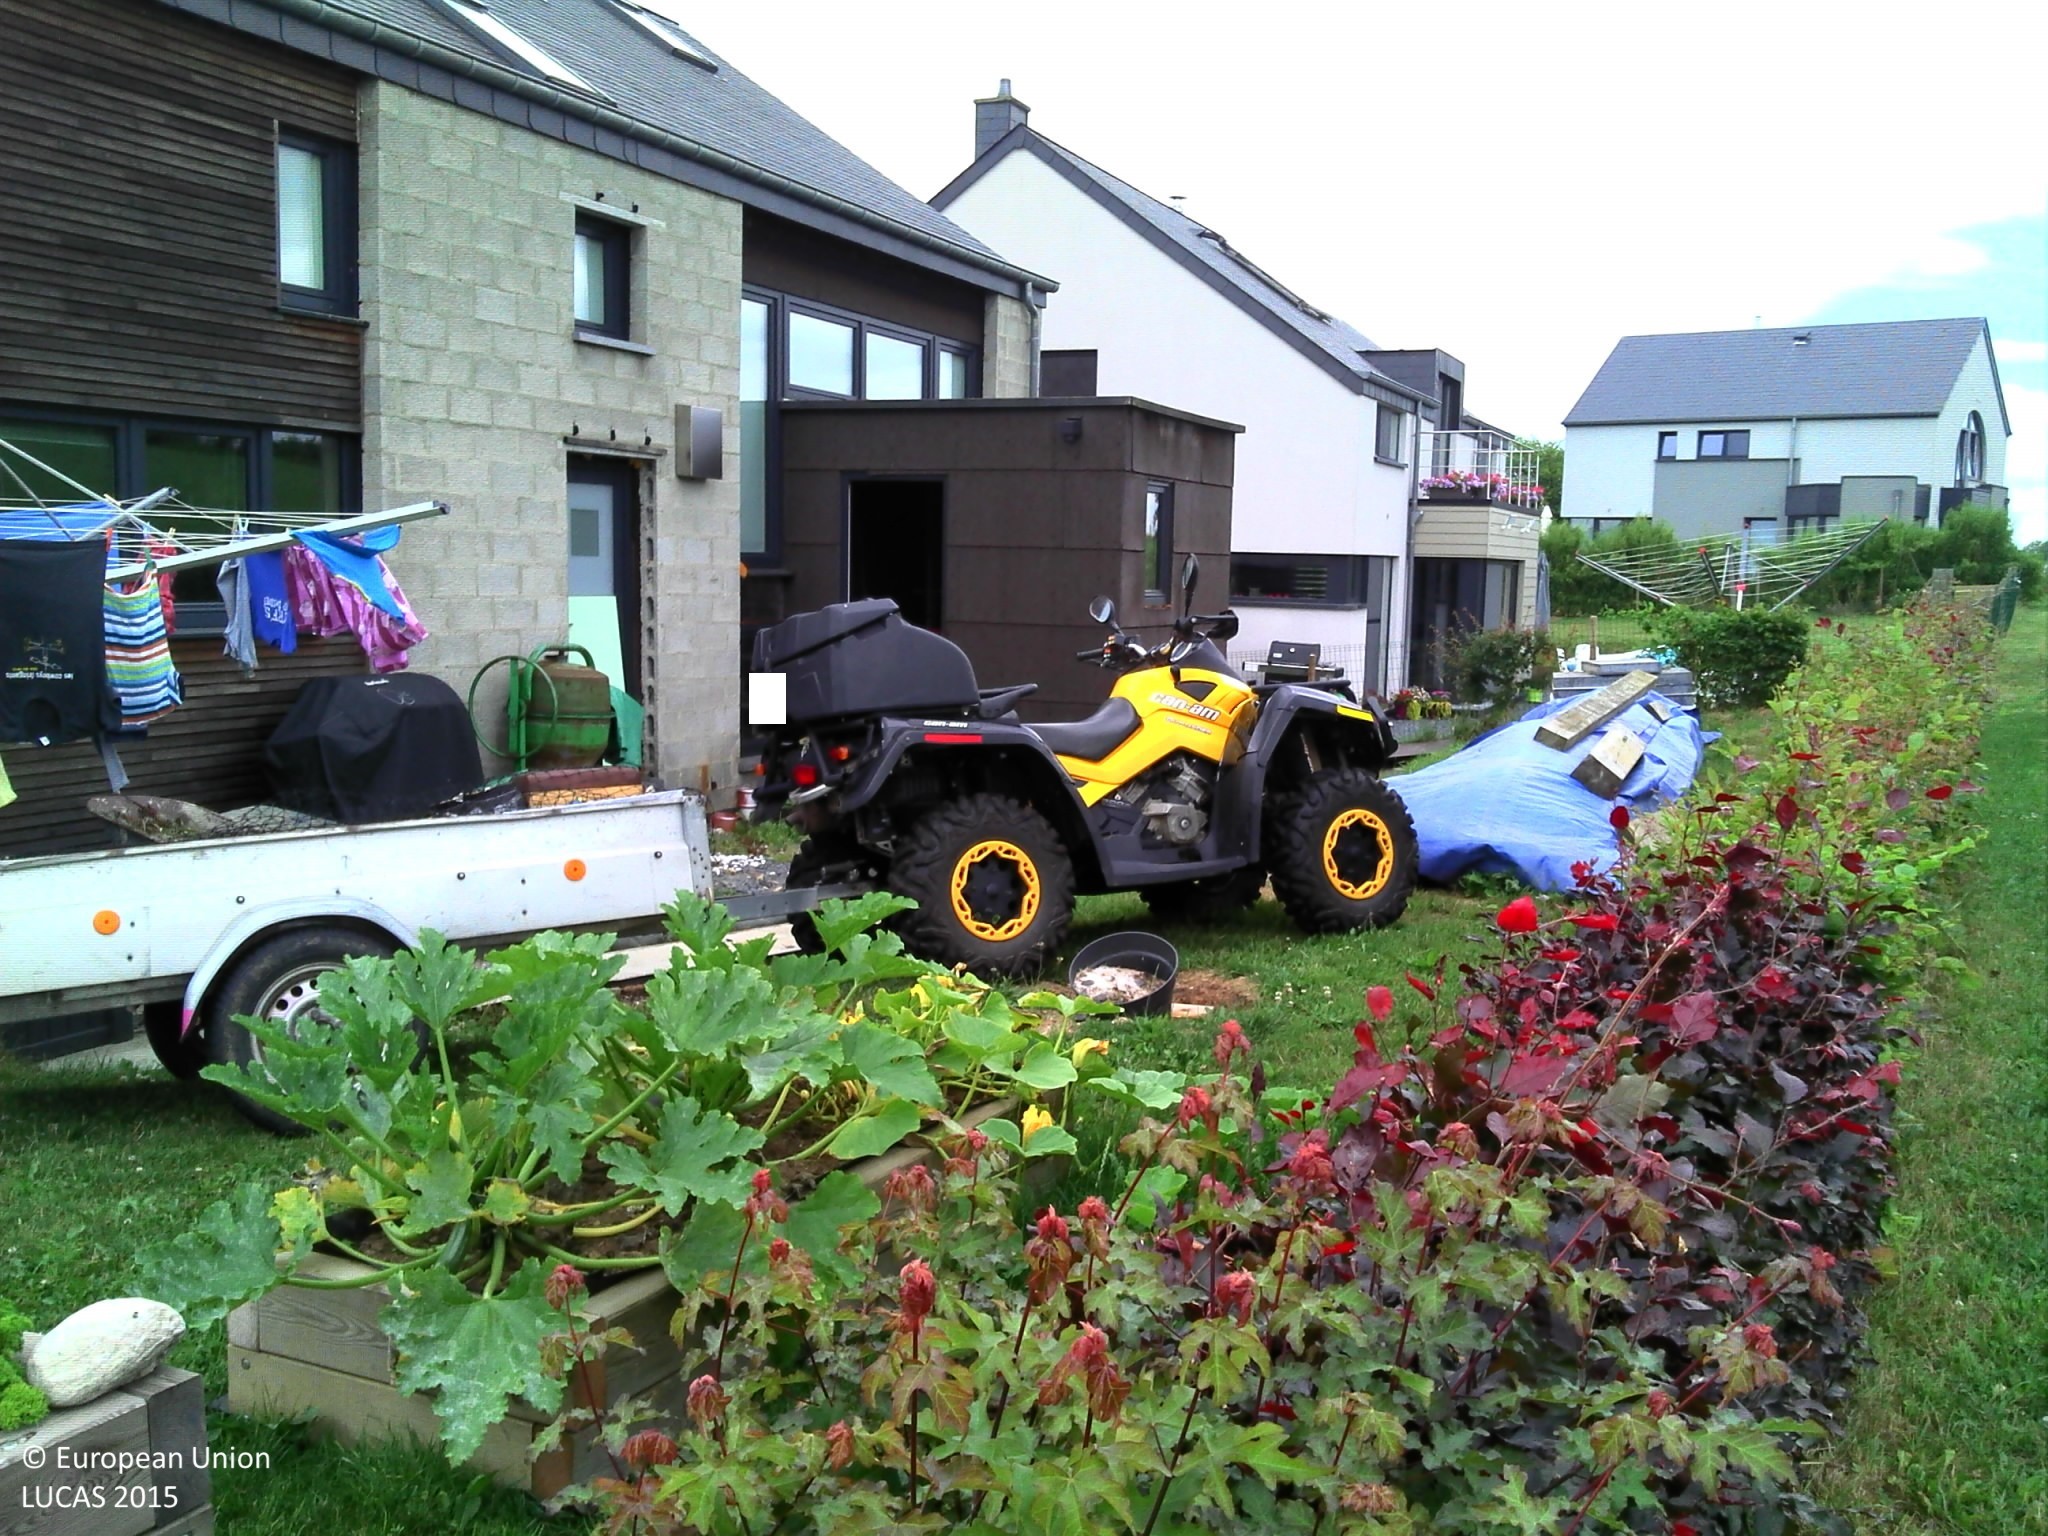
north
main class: Grassland
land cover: Grassland without tree/shrub cover
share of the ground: > 75 %
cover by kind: herbaceous plants 100 %
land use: Residential
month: July
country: BE
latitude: 49.7761
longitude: 5.6244
